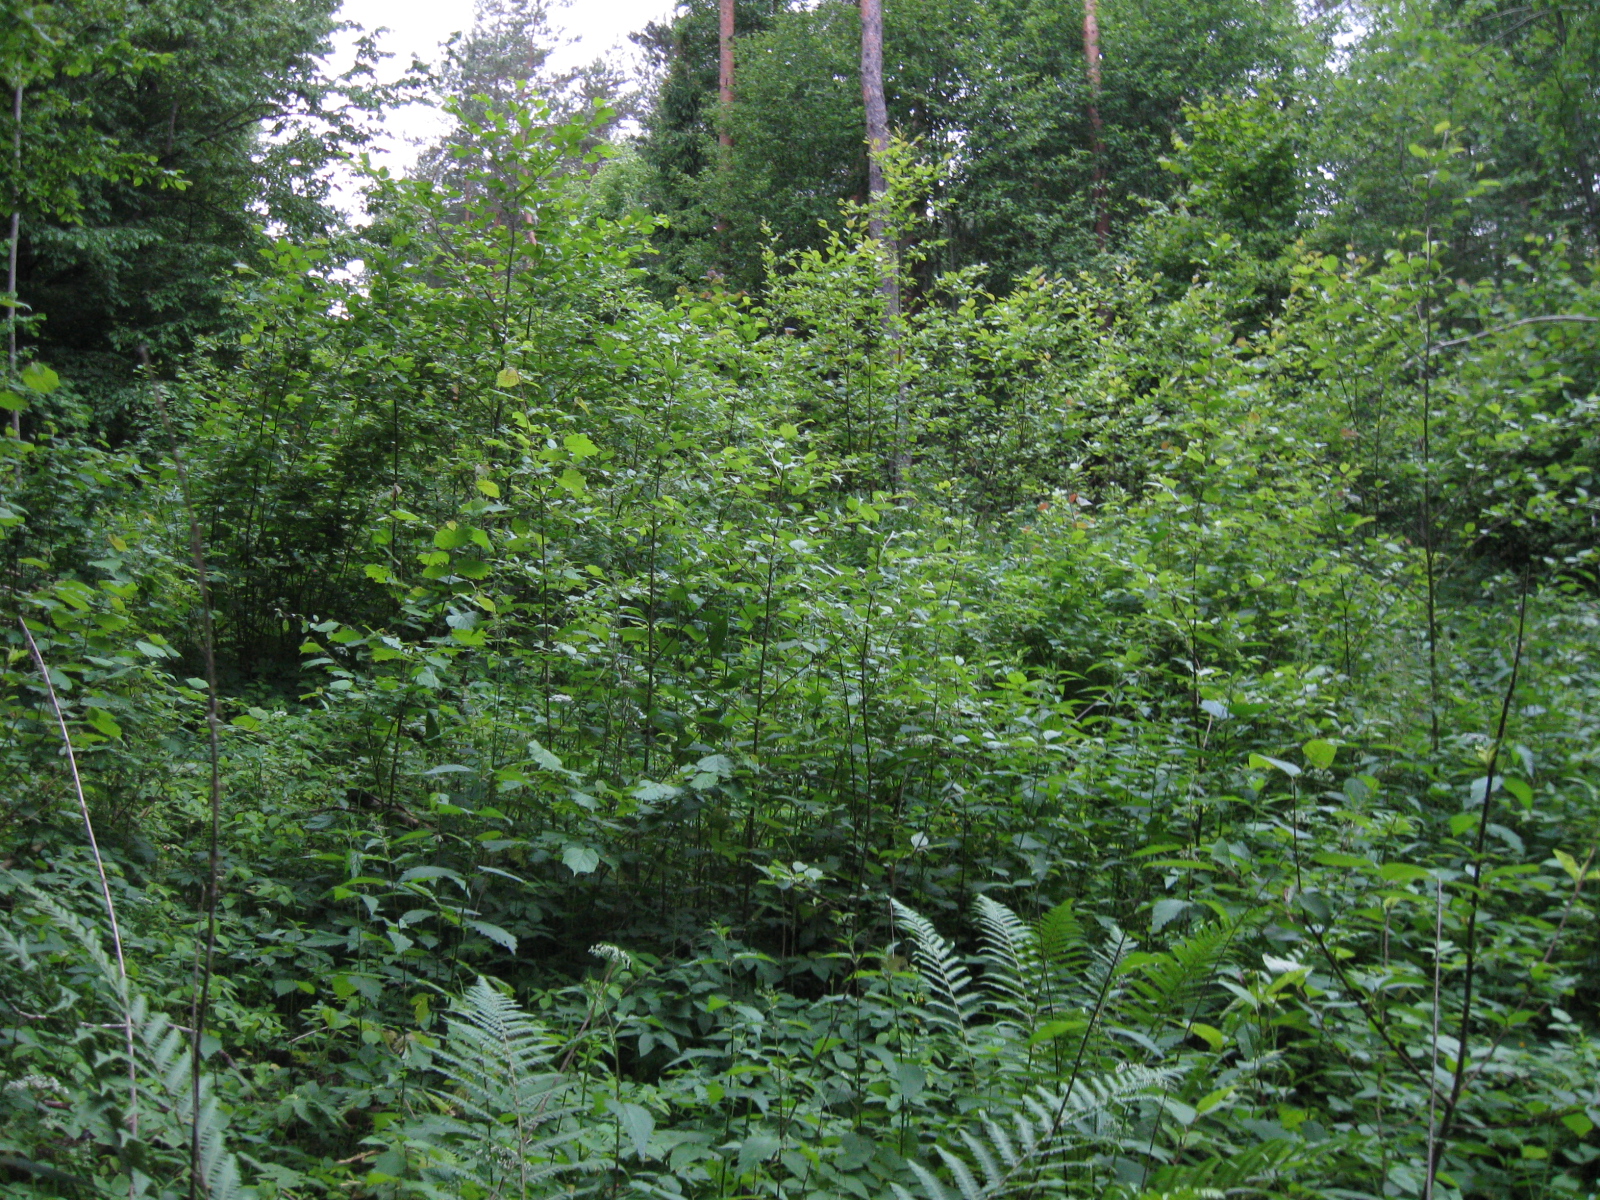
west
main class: Woodland
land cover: Broadleaved woodland
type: non-riverine alder, birch or aspen forest
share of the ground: > 75 %
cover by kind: broadleaved forest trees 80 %, coniferous forest trees 10 %, herbaceous plants 10 %
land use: Forestry
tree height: > 5 m
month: June
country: LT
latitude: 54.6656
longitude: 24.4744
